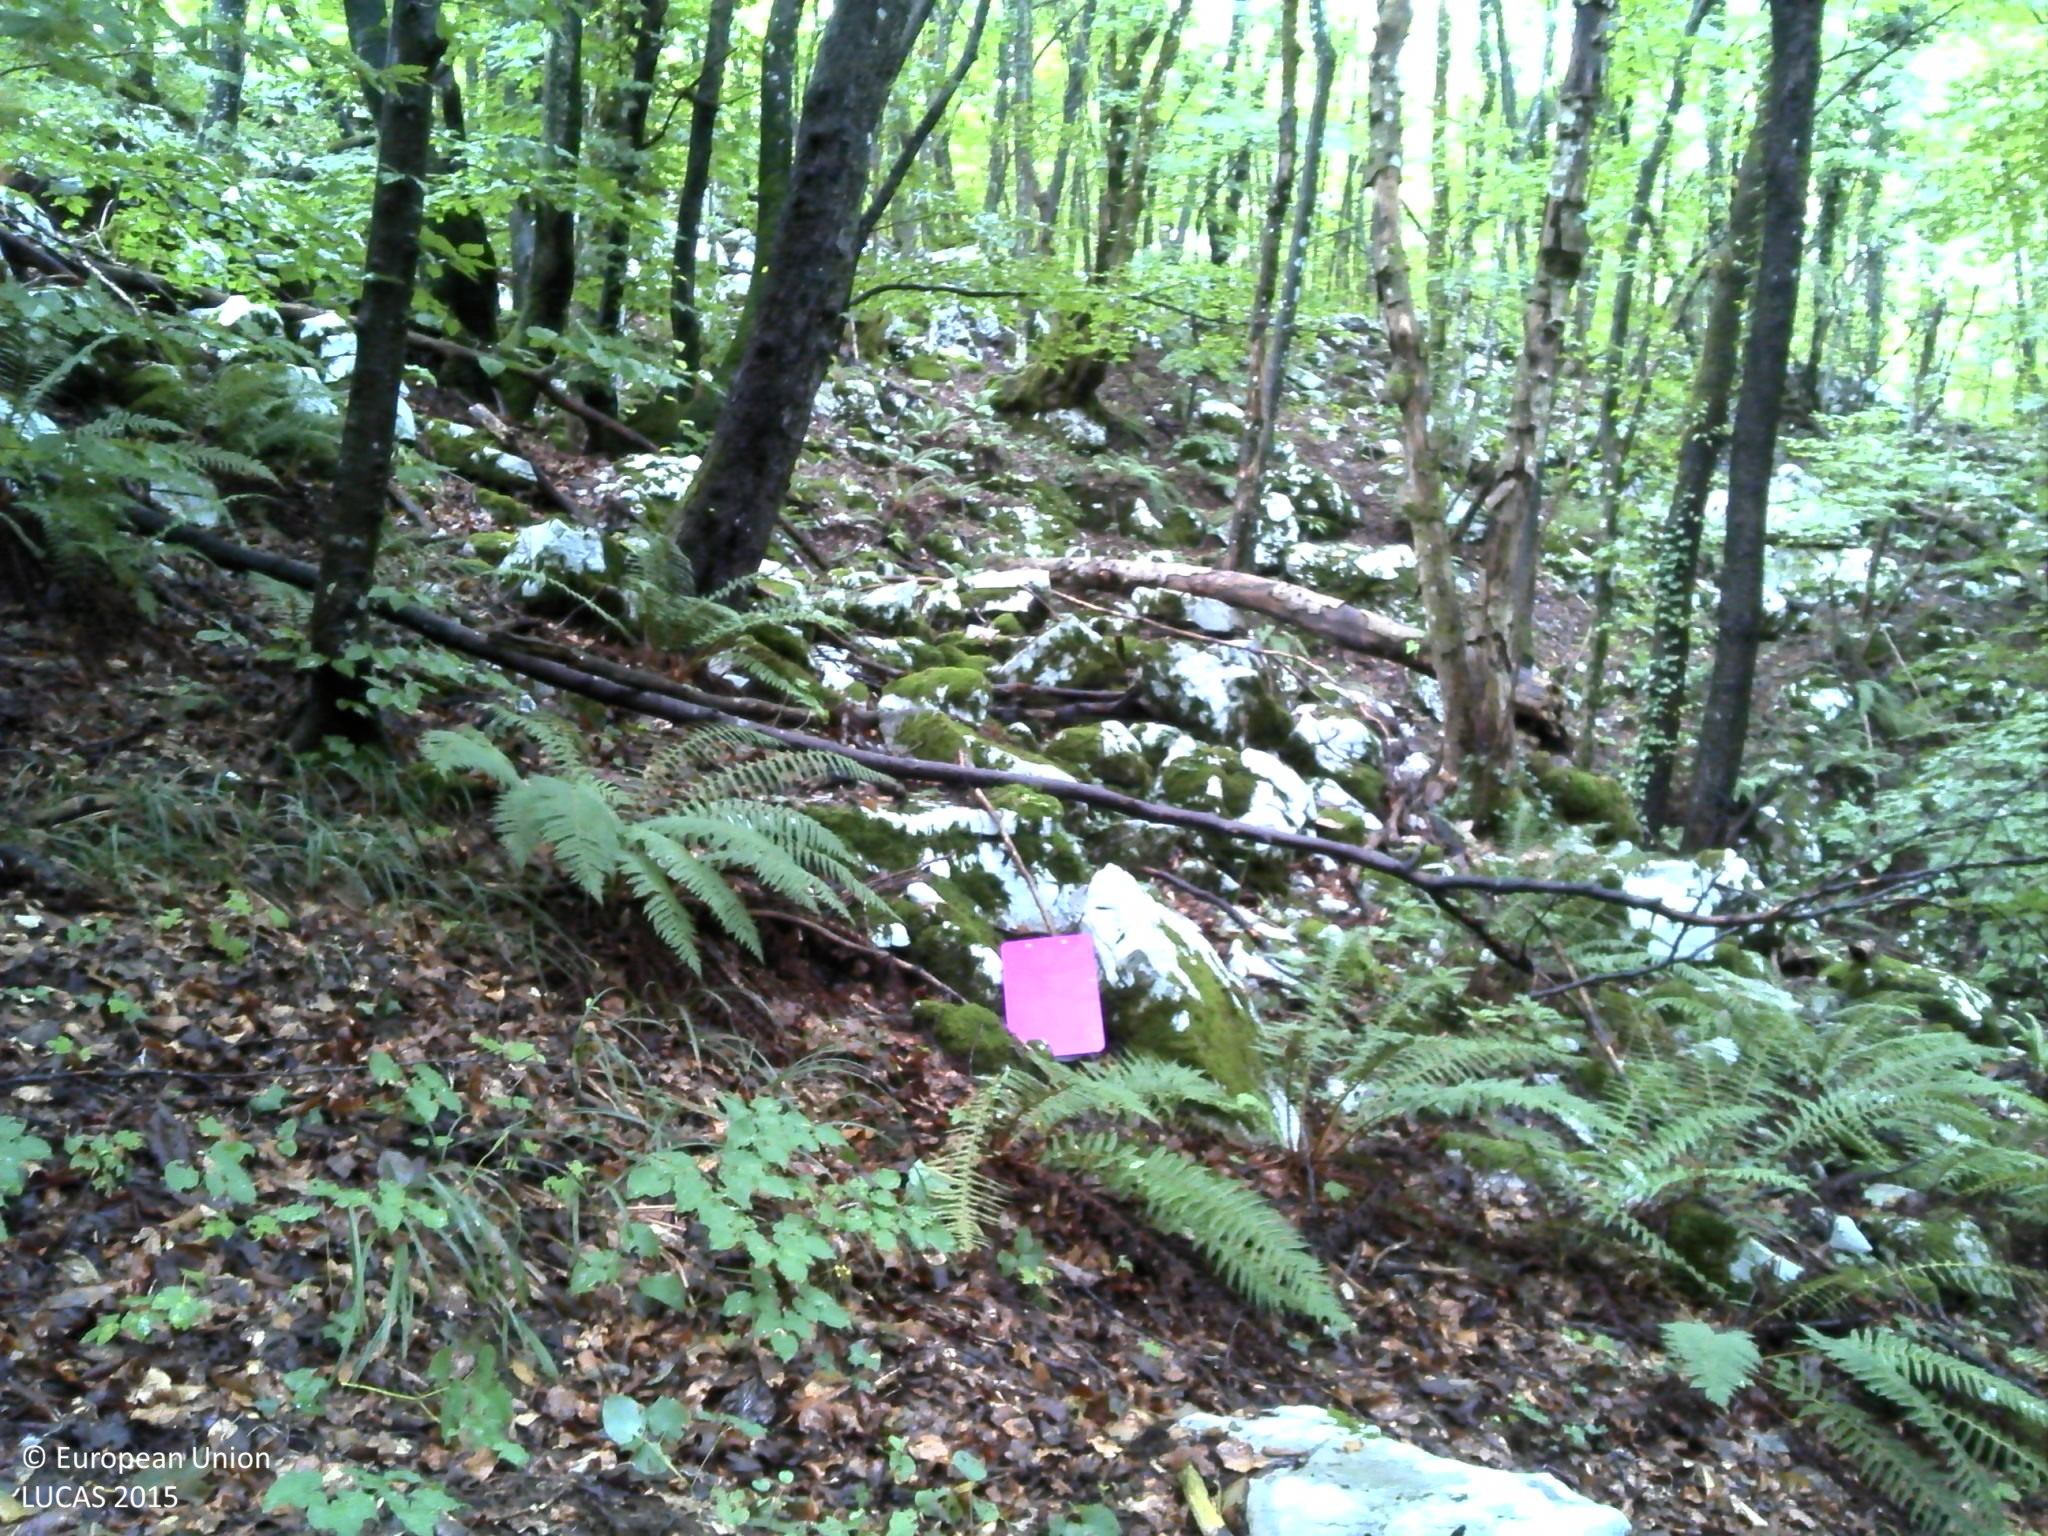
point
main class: Woodland
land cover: Broadleaved woodland
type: beech forest
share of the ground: > 75 %
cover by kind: broadleaved forest trees 100 %
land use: Forestry
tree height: > 5 m
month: September
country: HR
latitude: 45.2650
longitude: 15.2589
